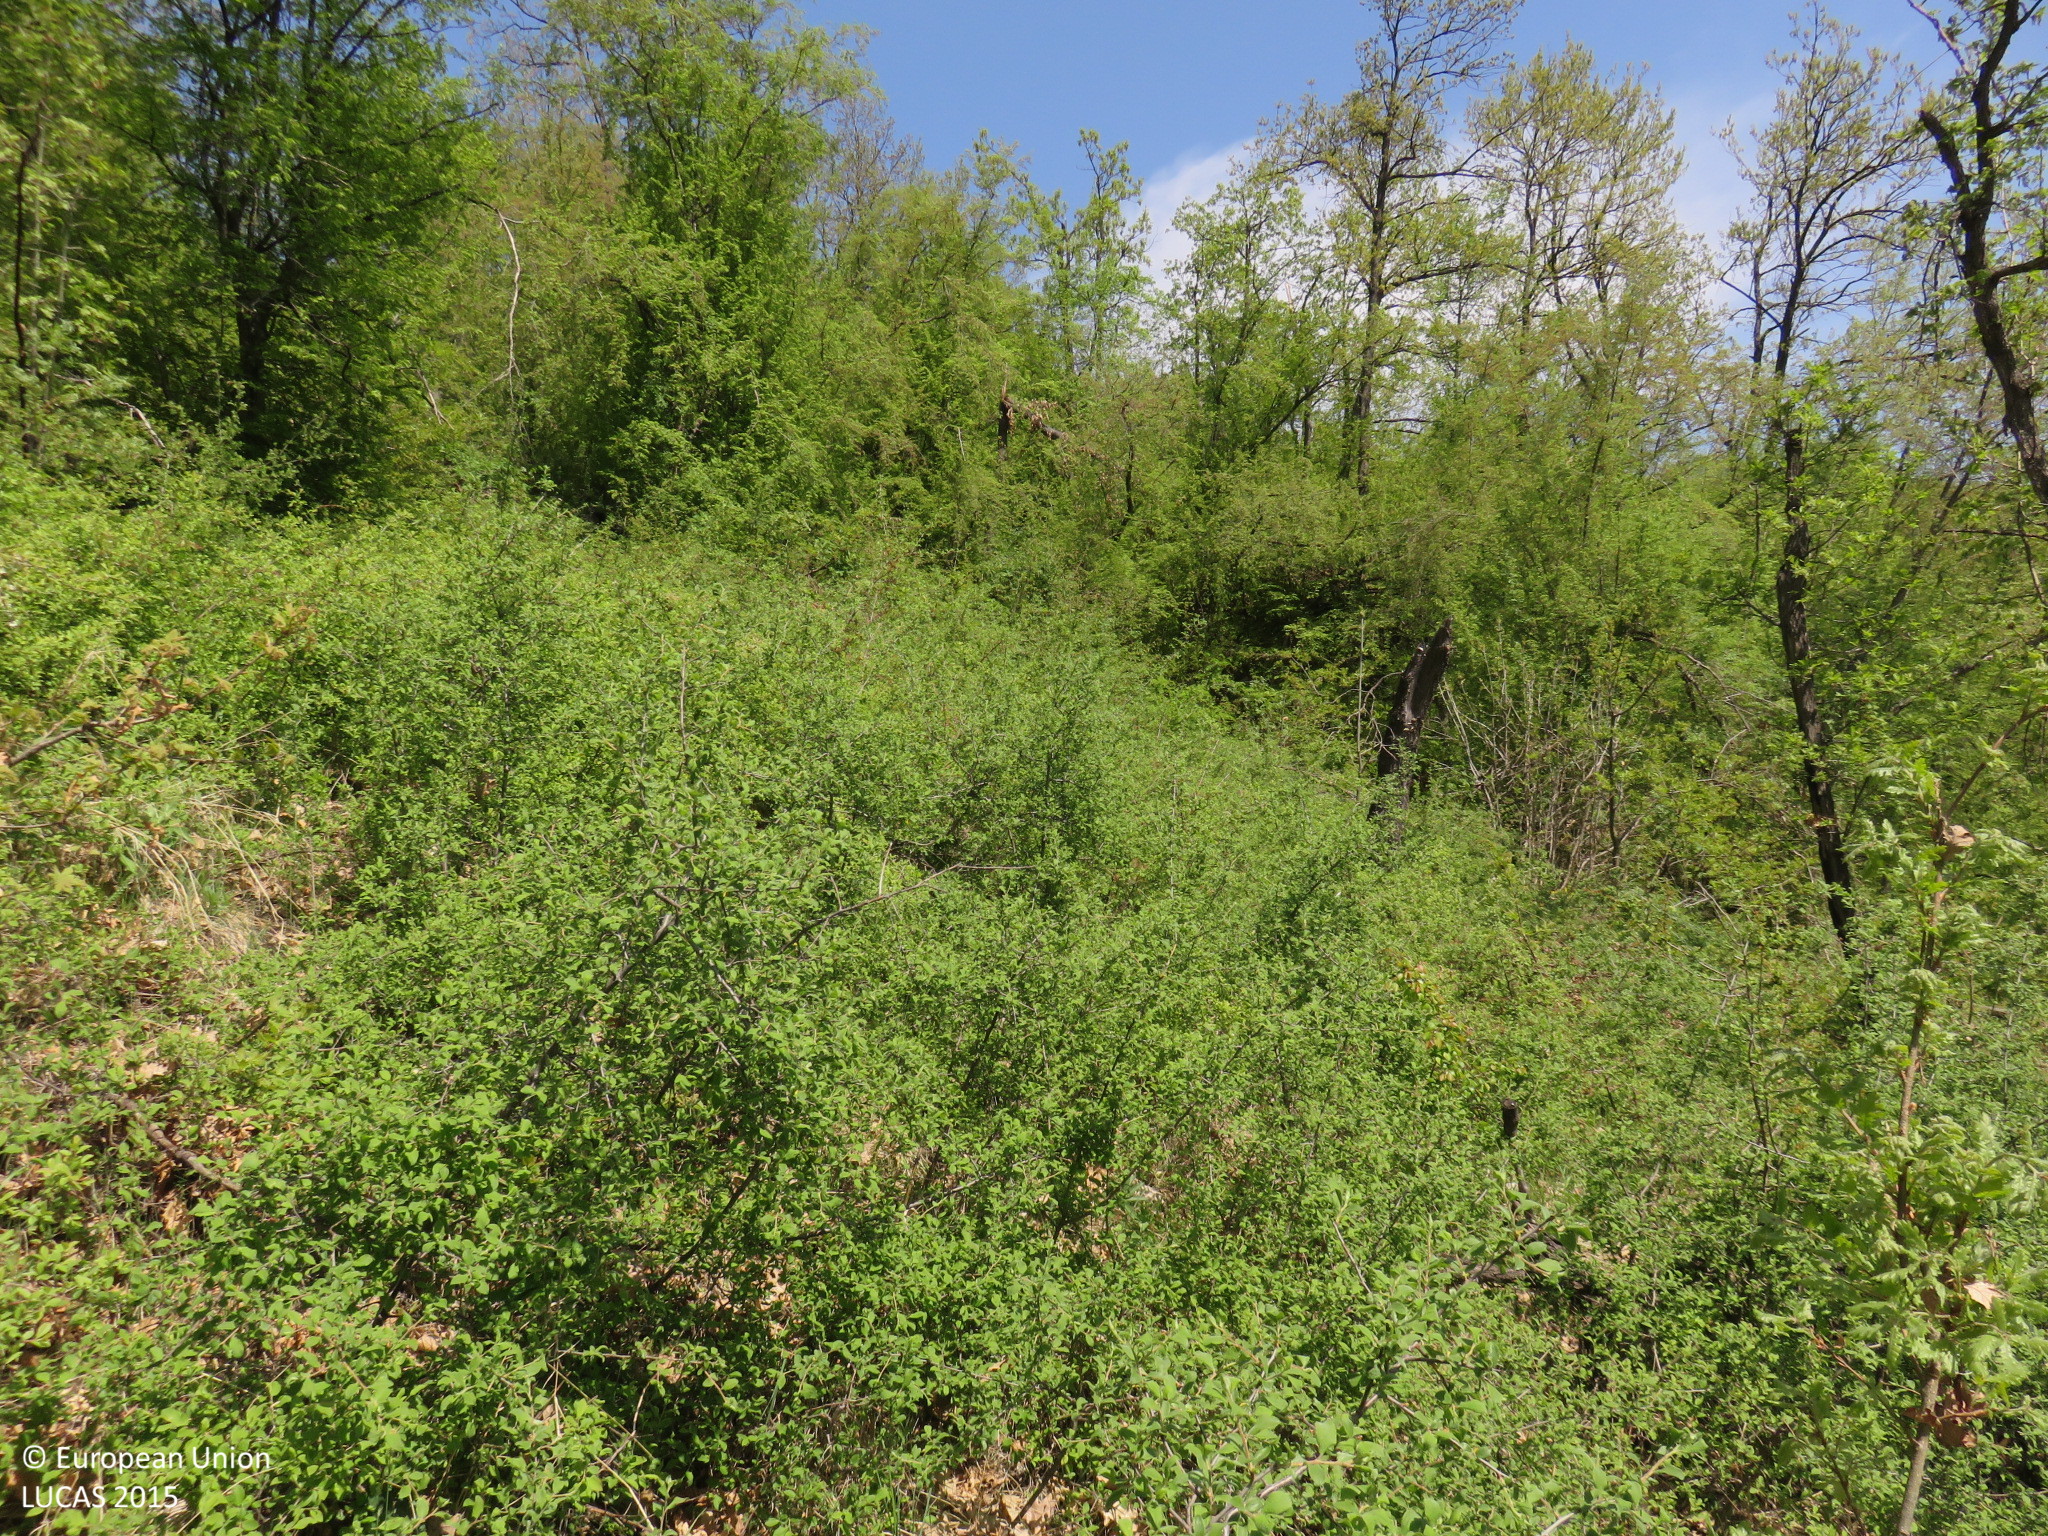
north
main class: Woodland
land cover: Broadleaved woodland
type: mesophytic deciduous forest
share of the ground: 50 - 75 %
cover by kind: broadleaved forest trees 55 %, shrubs 40 %, herbaceous plants 5 %
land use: Semi-natural and natural areas not in use
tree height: < 5 m
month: April
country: BG
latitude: 43.0293
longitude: 24.7767
